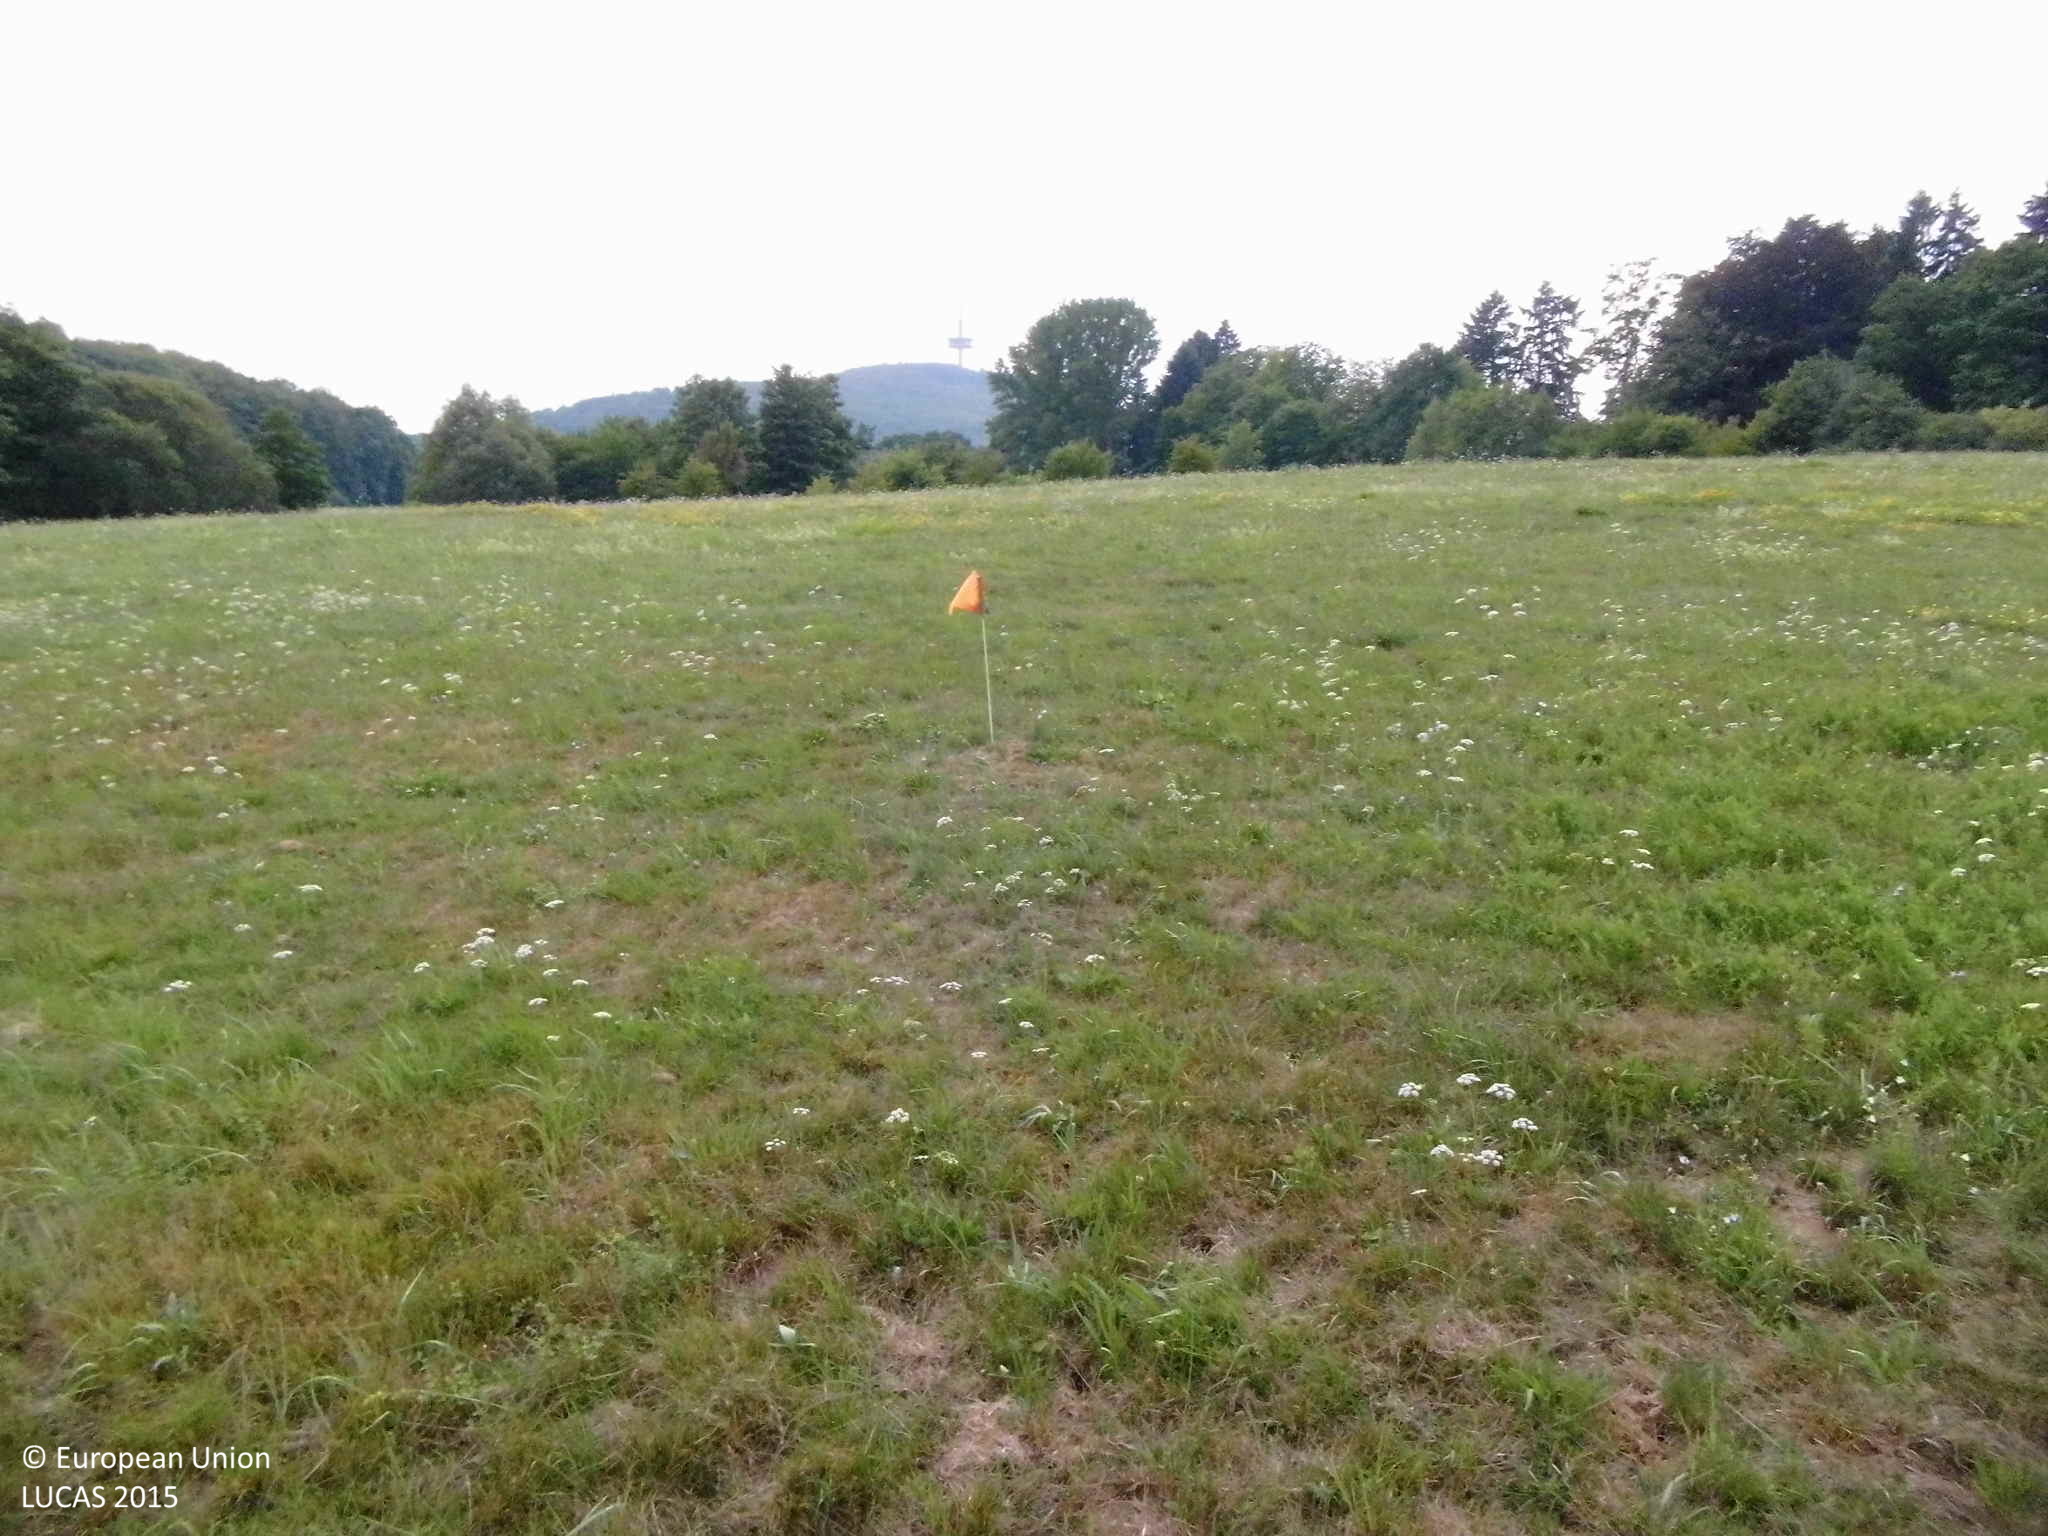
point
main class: Grassland
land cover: Grassland without tree/shrub cover
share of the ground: > 75 %
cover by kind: herbaceous plants 100 %
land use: Agriculture (excluding fallow land and kitchen gardens)
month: August
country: DE
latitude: 50.6612
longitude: 8.5998
